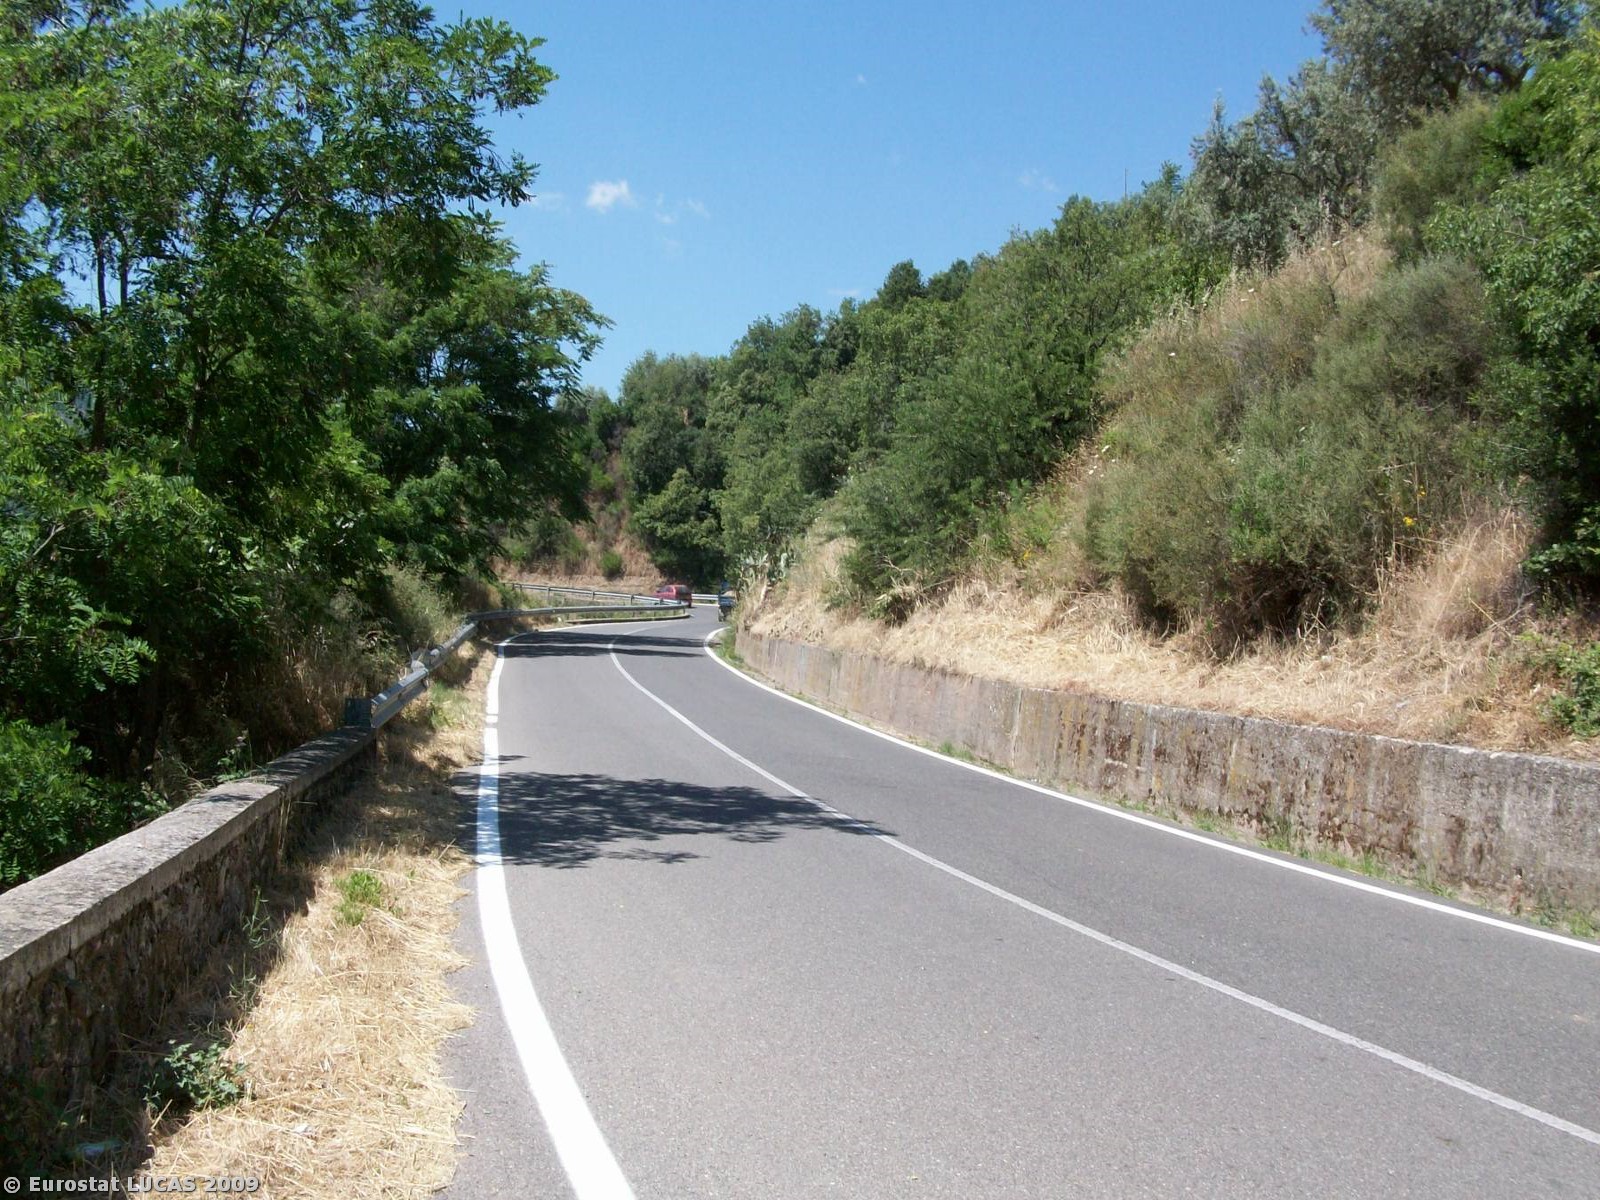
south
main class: Woodland
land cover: Broadleaved woodland
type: thermophilous deciduous forest
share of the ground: > 75 %
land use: Unused
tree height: > 5 m
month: June
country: IT
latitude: 39.4915
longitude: 16.7252
